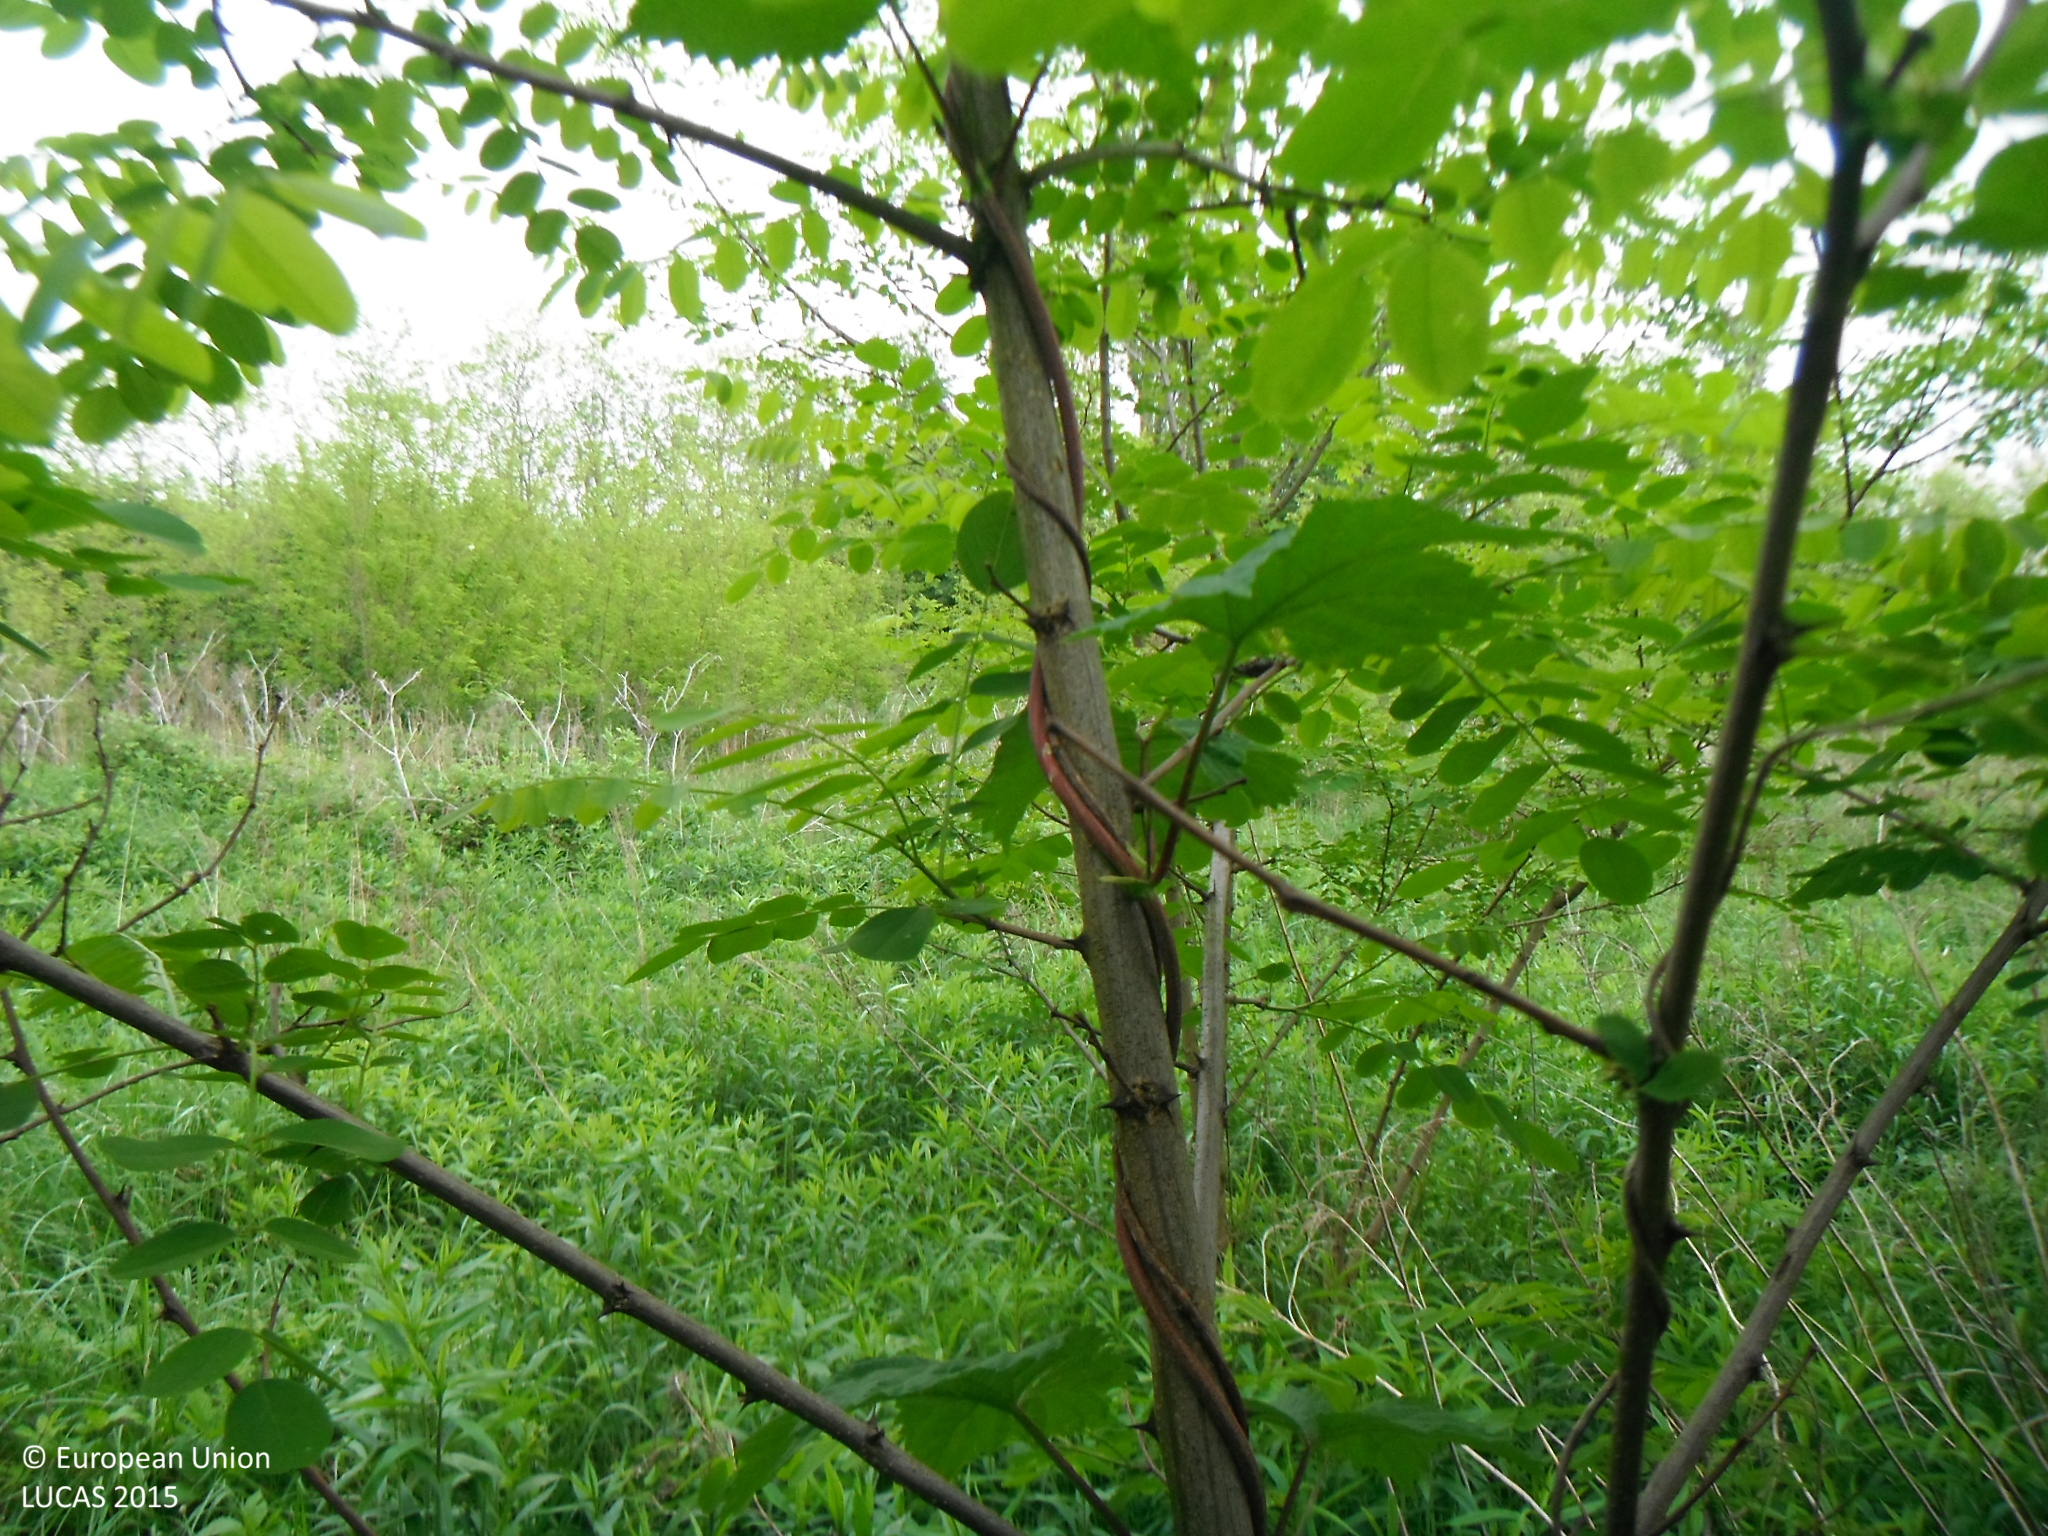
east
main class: Shrubland
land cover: Shrubland with sparse tree cover
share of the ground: > 75 %
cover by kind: herbaceous plants 80 %, shrubs 15 %, broadleaved forest trees 5 %
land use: Abandoned areas
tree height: < 5 m
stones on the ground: < 10 %
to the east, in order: Shrubland with sparse tree cover; Grass margins; Paved roads, cycling and walking lanes; Broadleaved woodland; Paved roads, cycling and walking lanes; Pine dominated coniferous woodland; Broadleaved woodland; Pine dominated coniferous woodland; Broadleaved woodland; Pine dominated coniferous woodland; Broadleaved woodland; Spontaneously vegetated surfaces
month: May
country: SK
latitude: 48.3971
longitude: 17.0178
